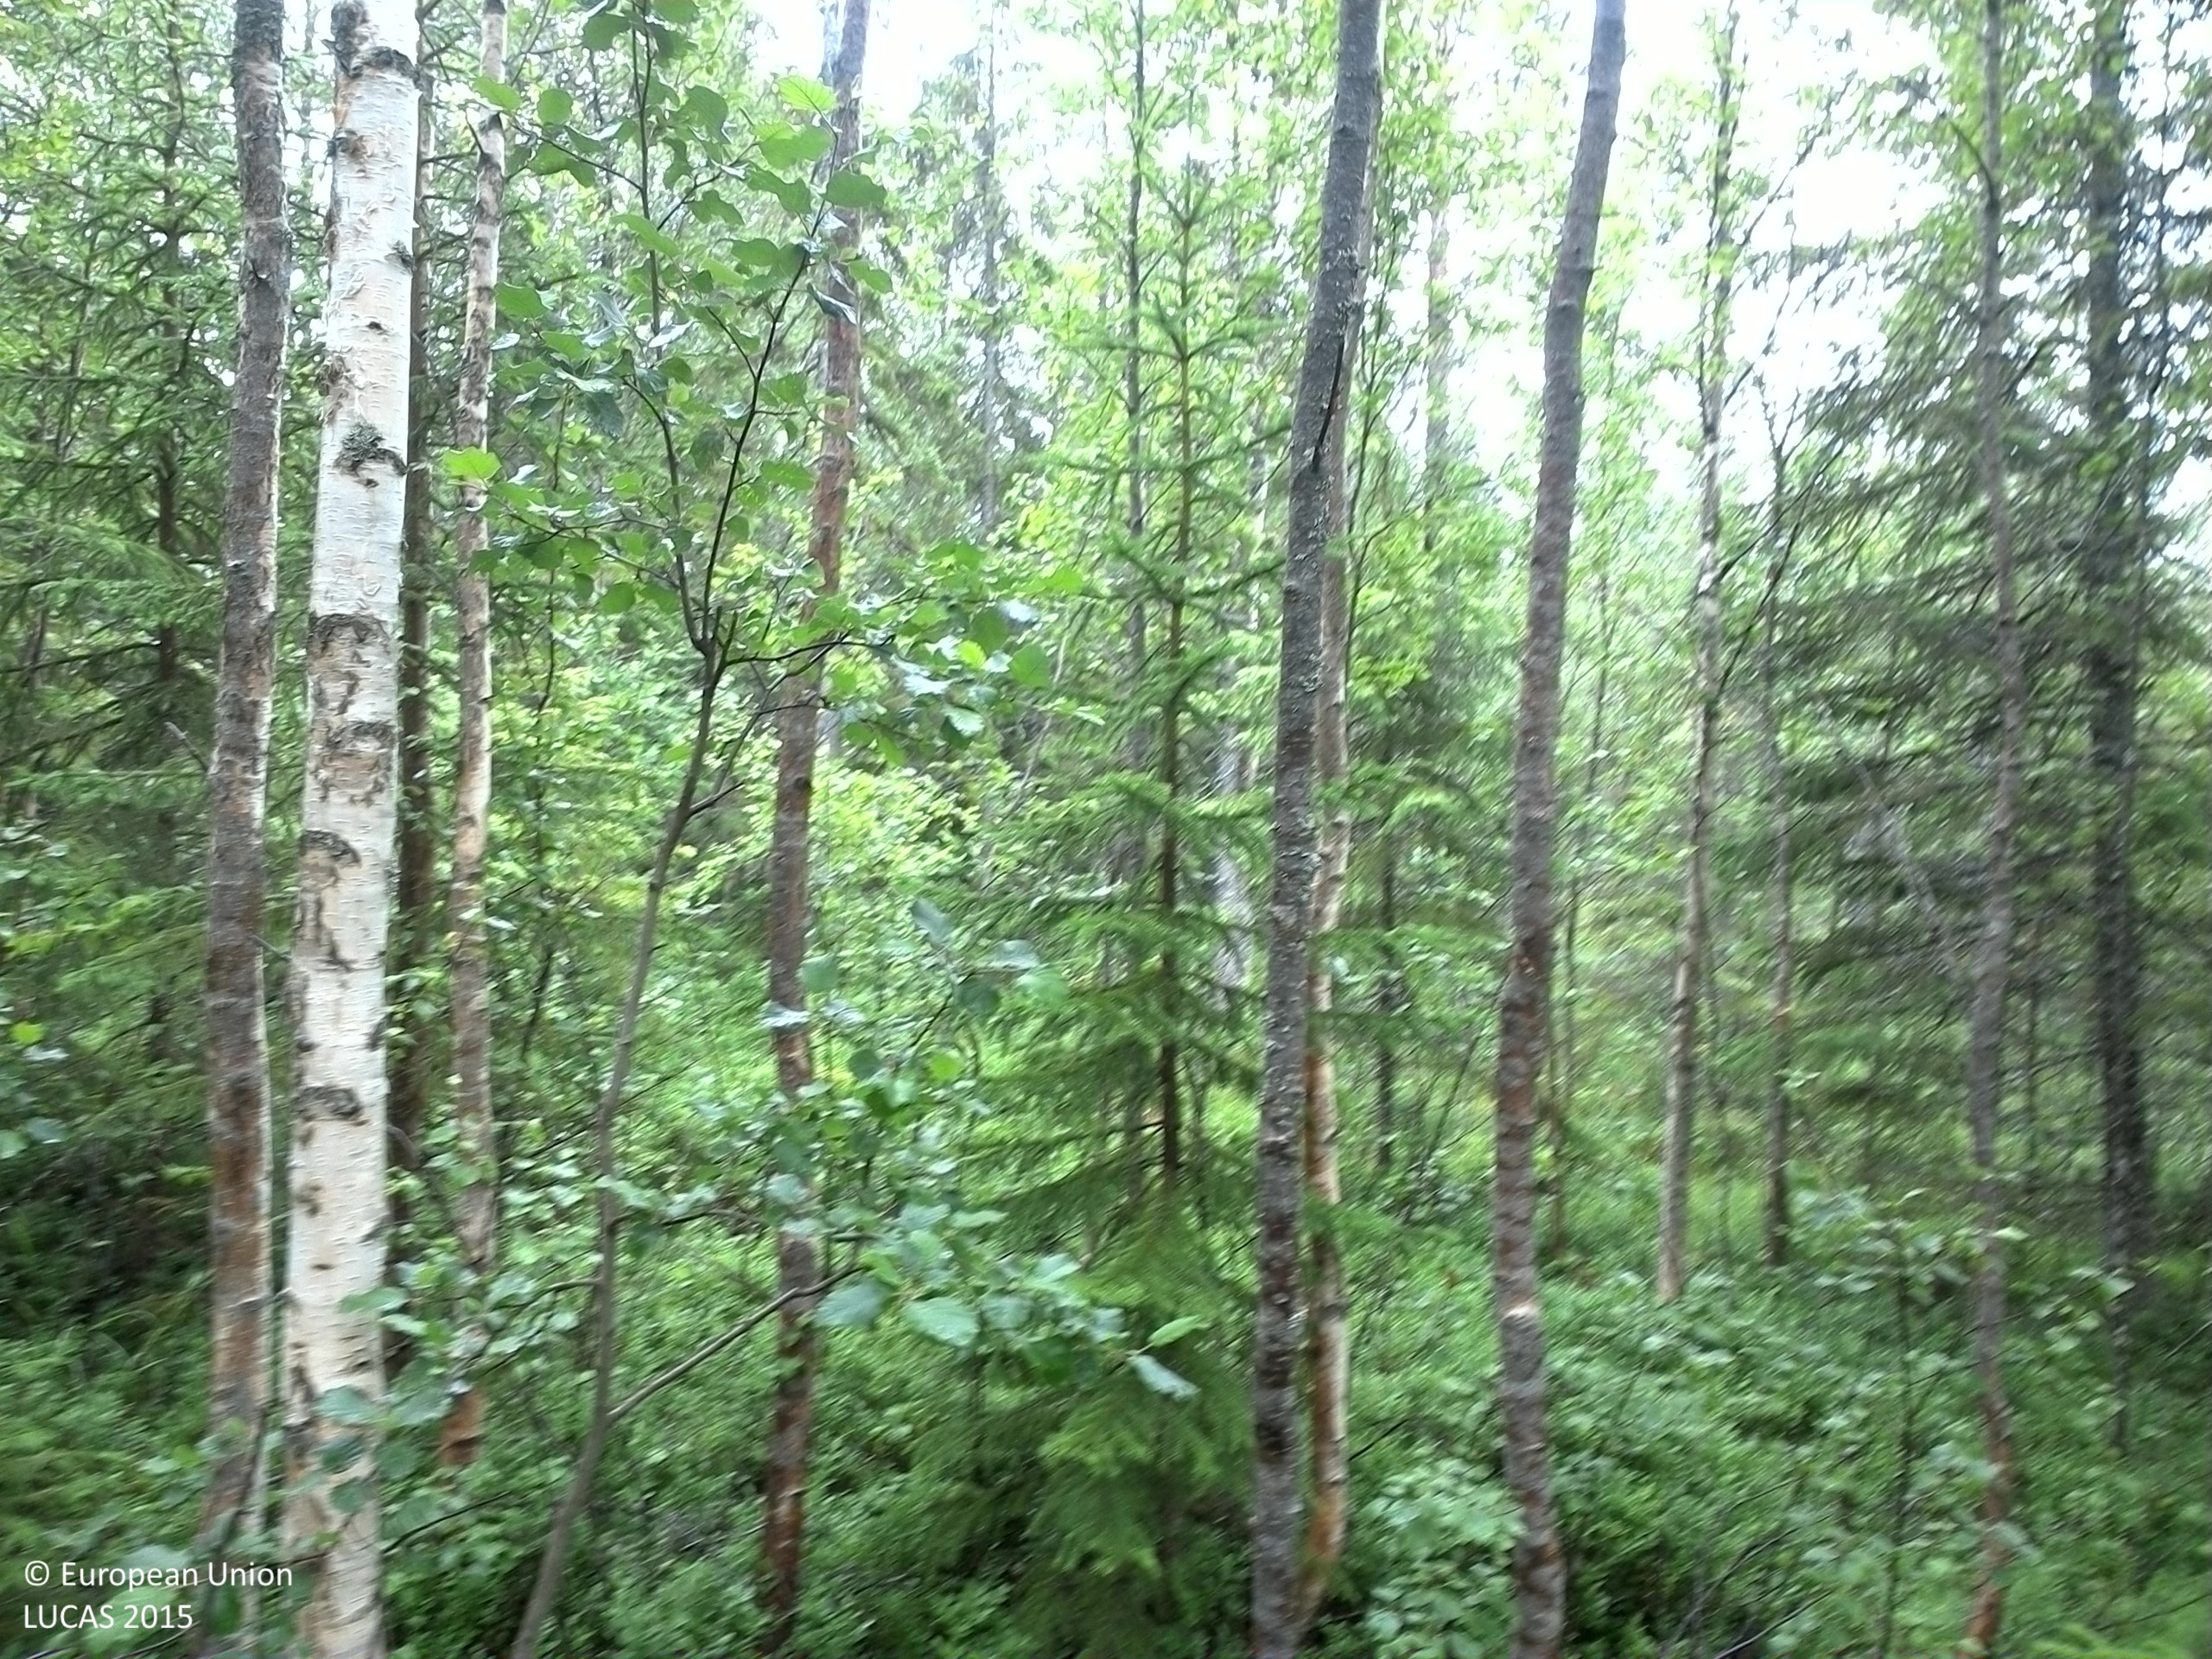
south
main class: Woodland
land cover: Spruce dominated mixed woodland
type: boreal forest
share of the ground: > 75 %
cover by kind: coniferous forest trees 45 %, broadleaved forest trees 40 %, shrubs 15 %
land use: Forestry
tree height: > 5 m
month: July
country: SE
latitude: 62.6726
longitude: 17.2618
